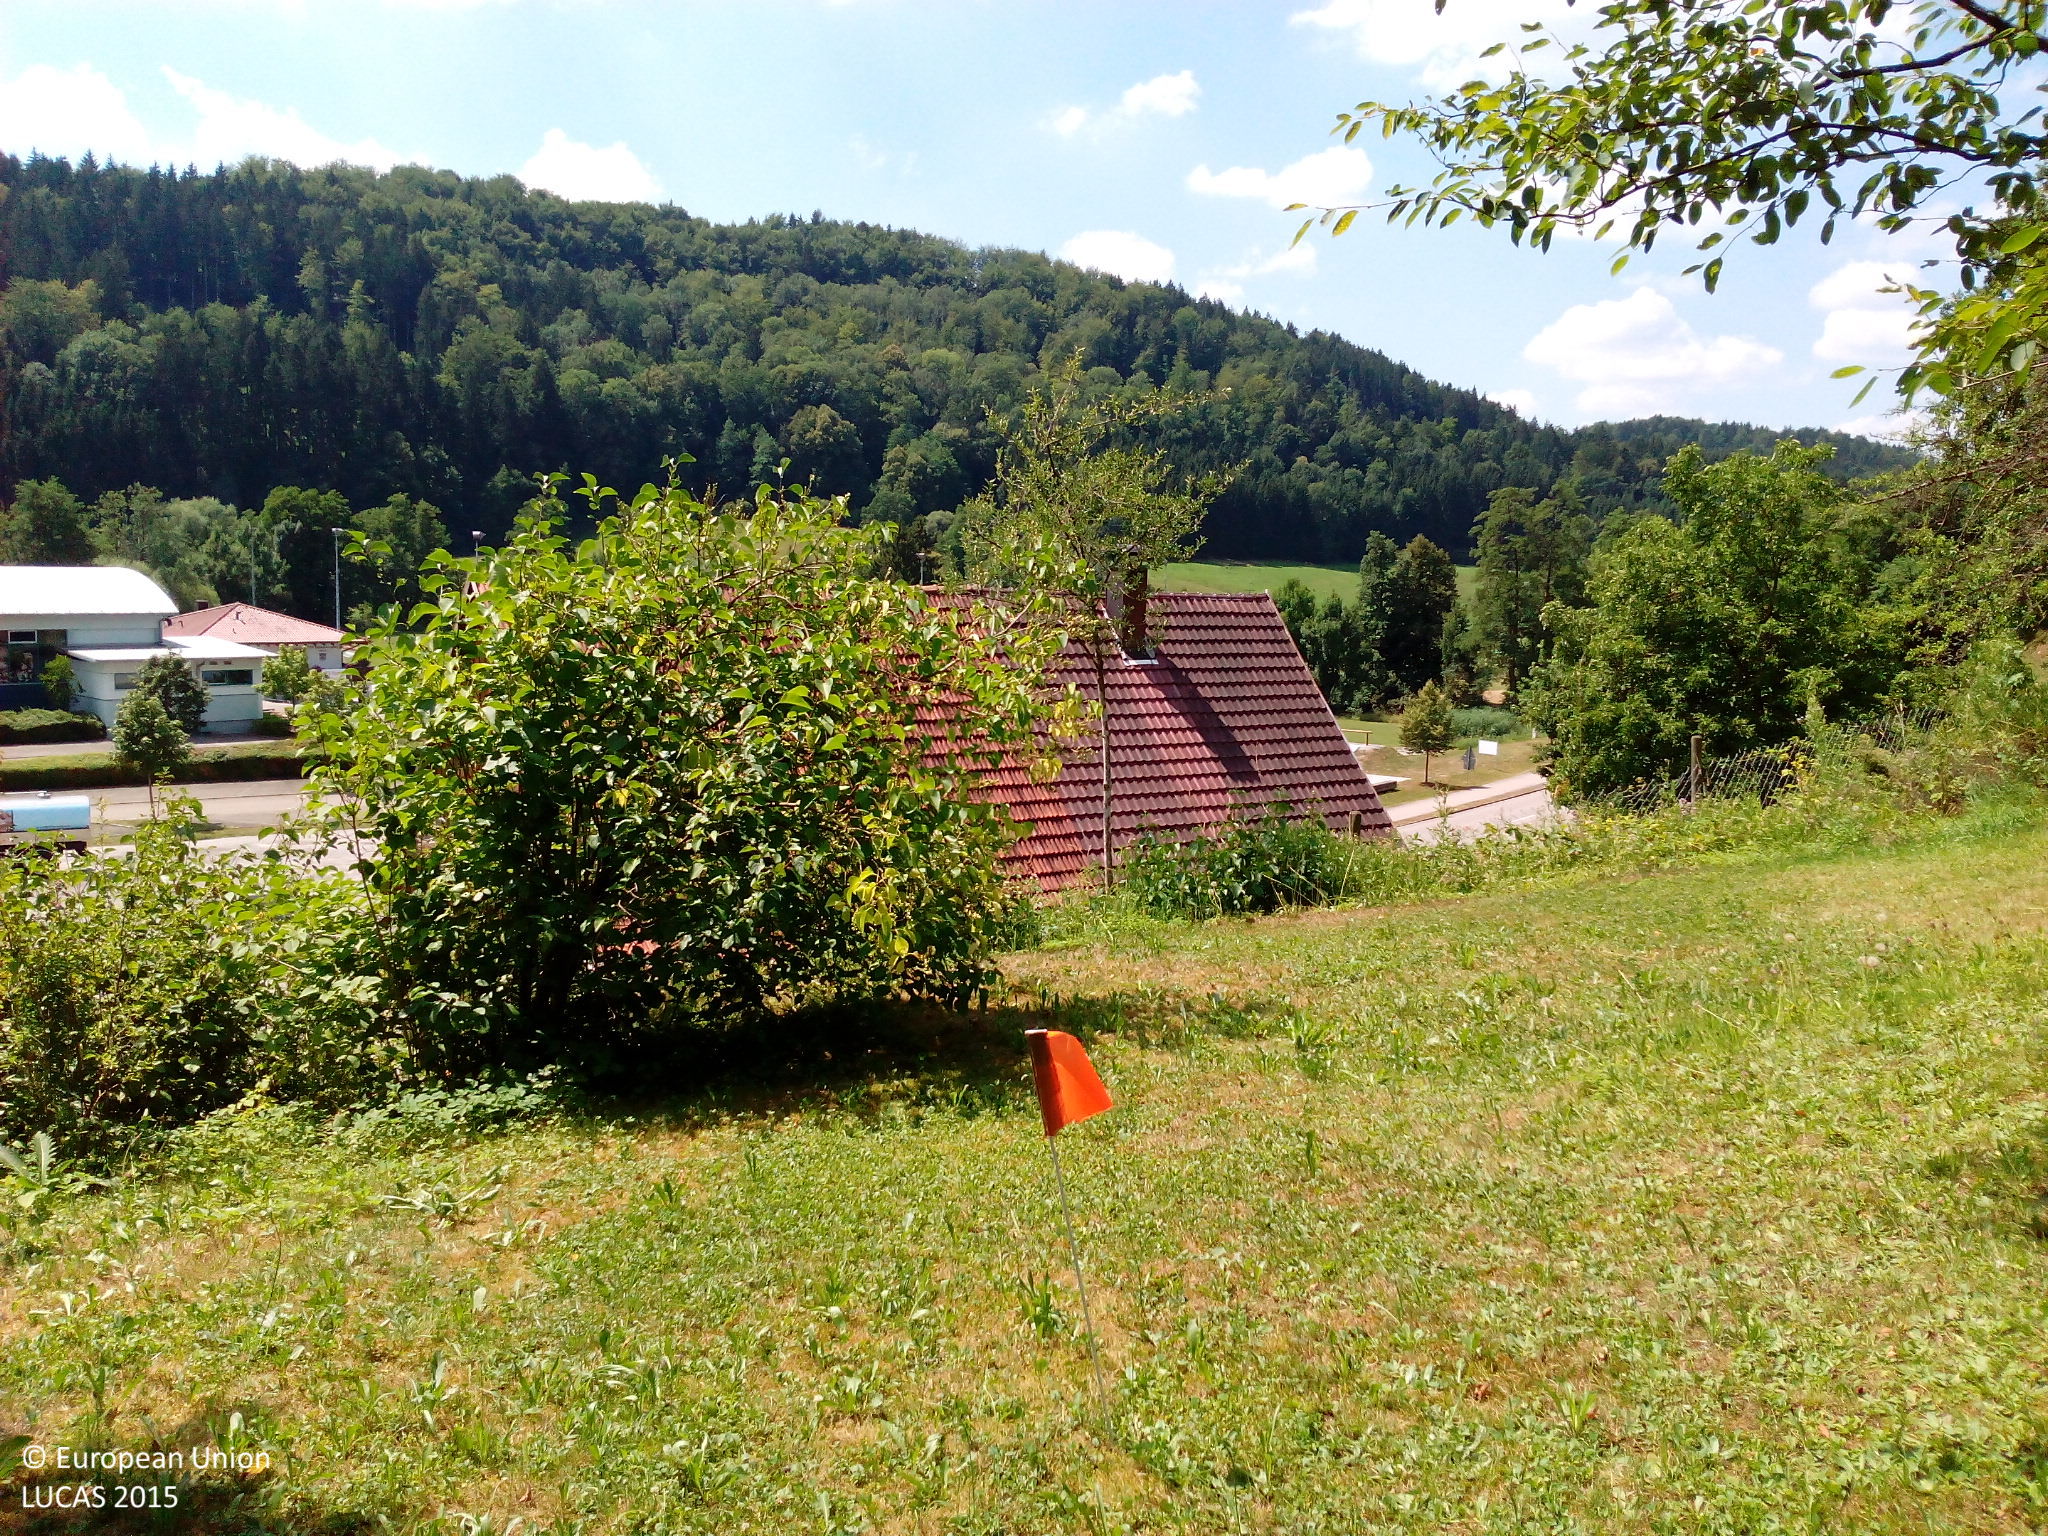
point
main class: Grassland
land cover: Grassland without tree/shrub cover
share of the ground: > 75 %
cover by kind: herbaceous plants 100 %
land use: Residential
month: July
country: DE
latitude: 48.9611
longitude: 9.8498
